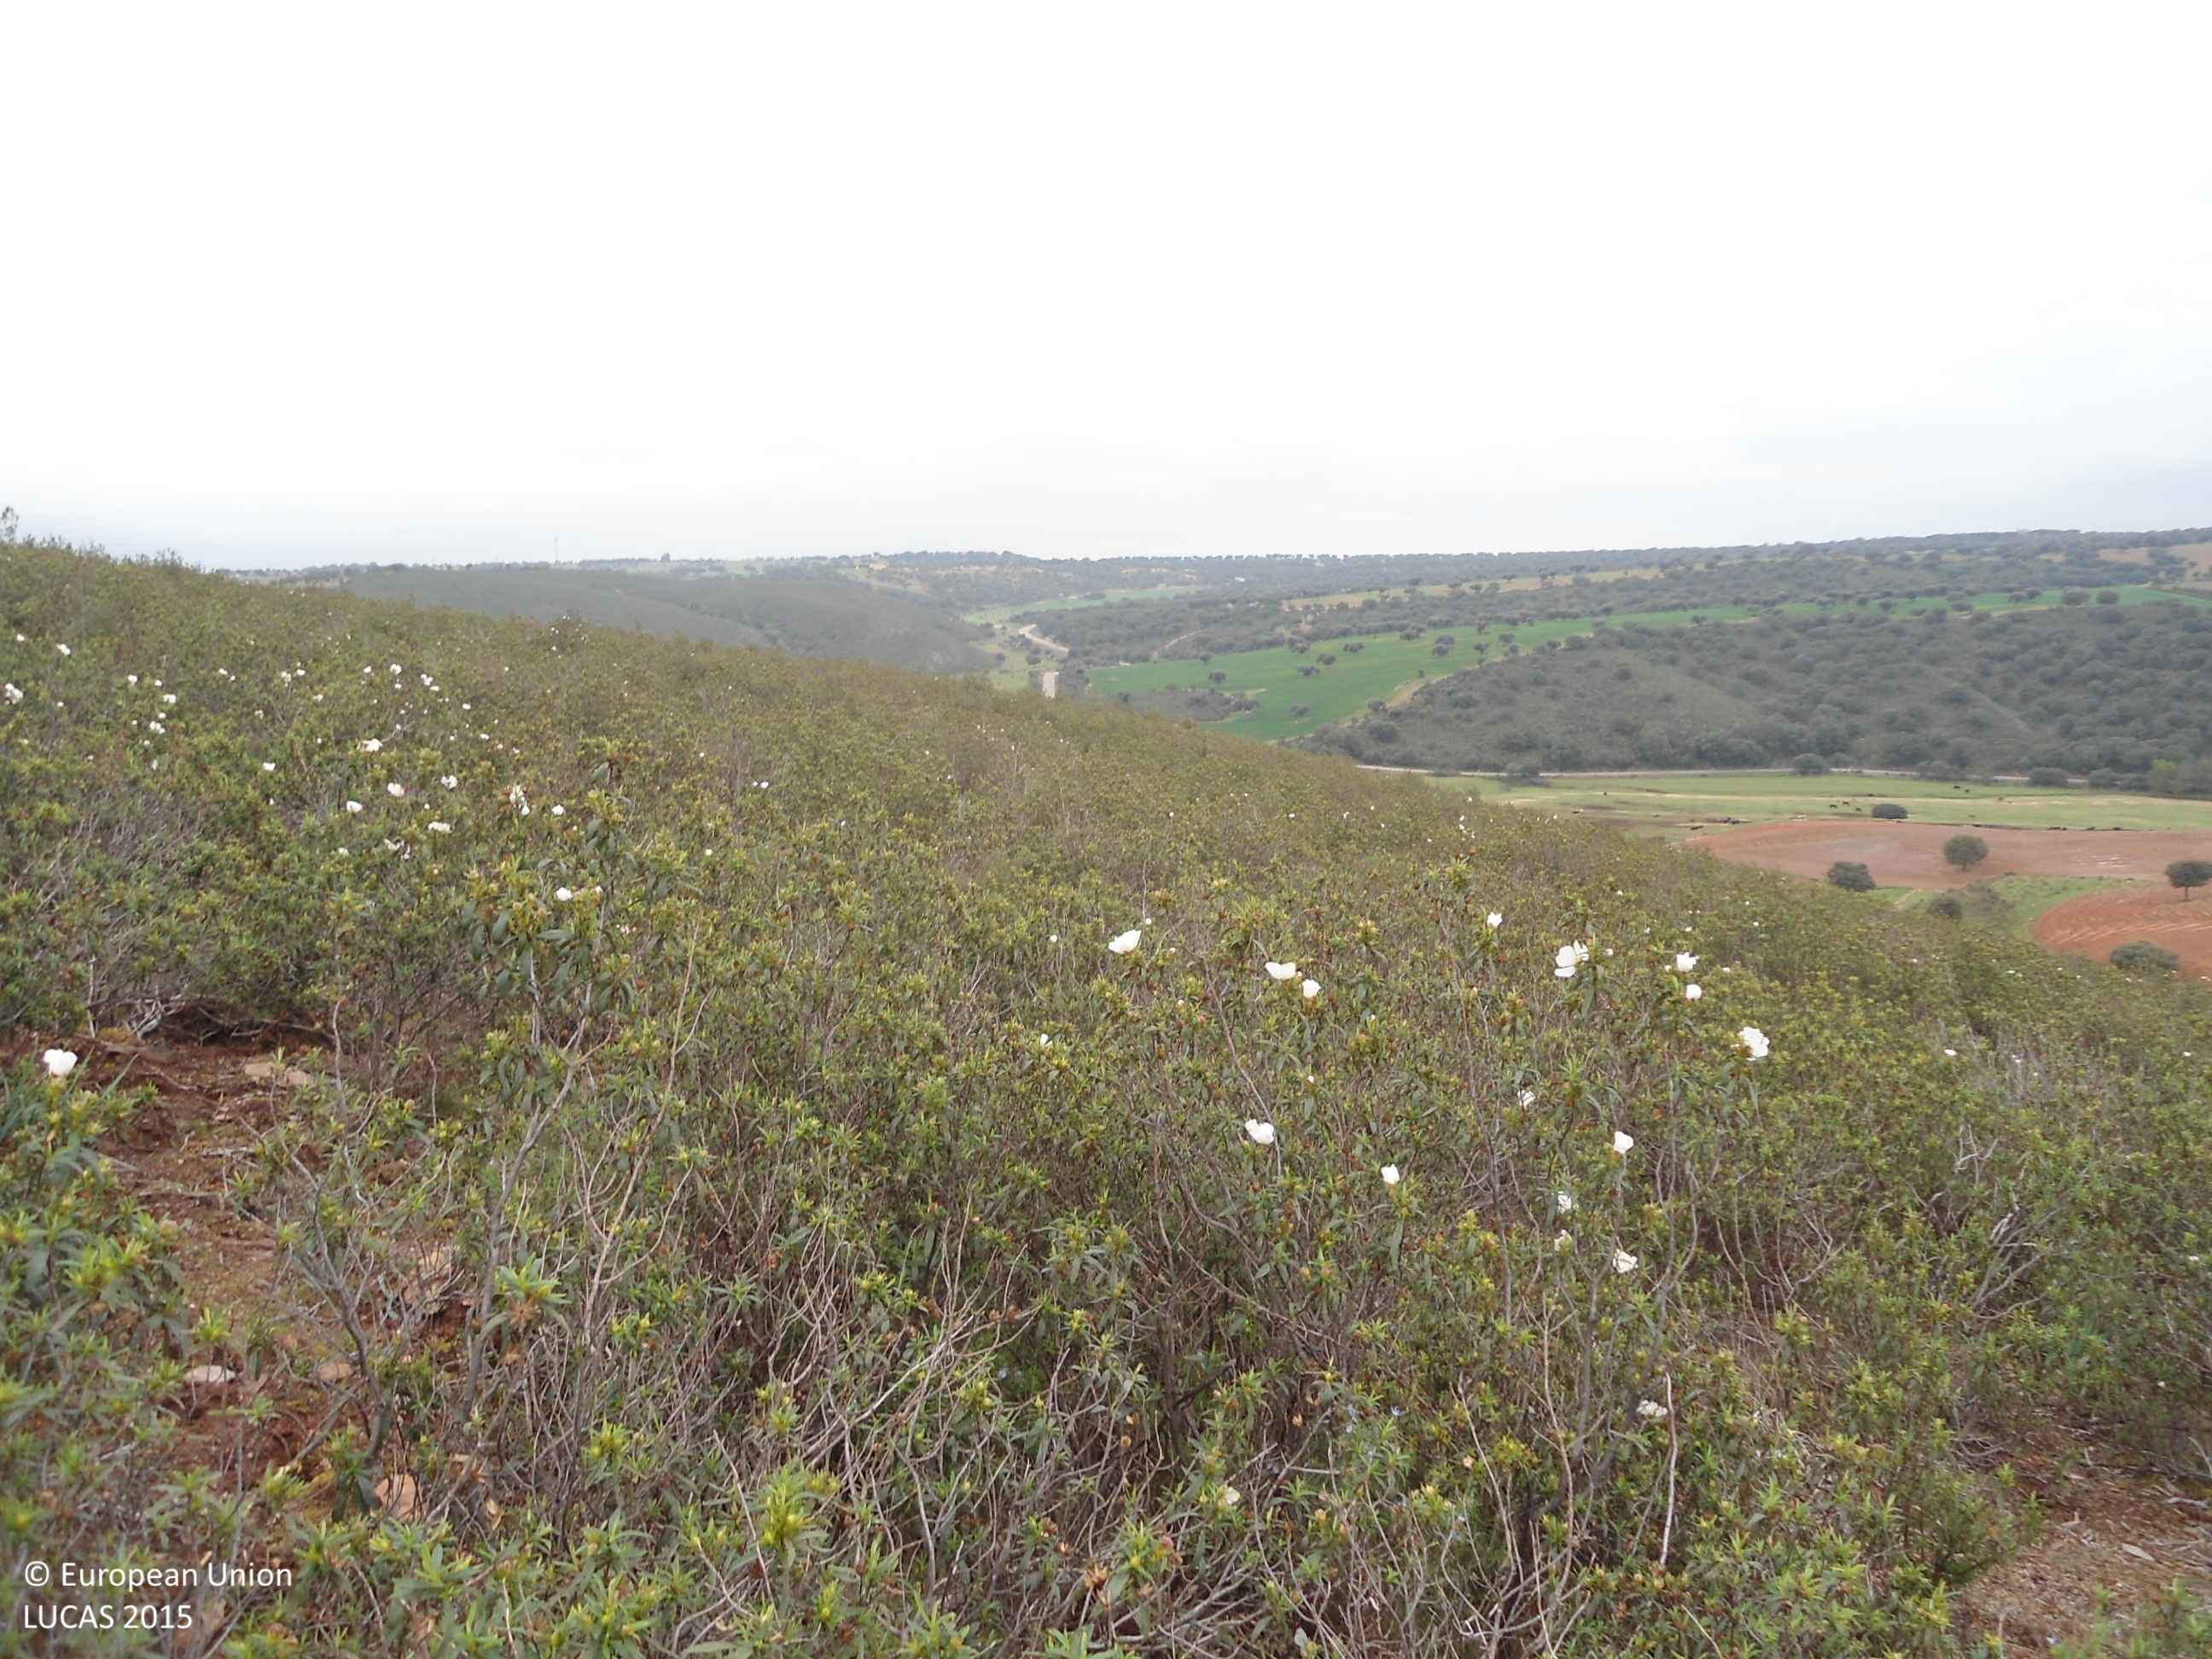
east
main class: Shrubland
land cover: Shrubland without tree cover
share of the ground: > 75 %
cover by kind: shrubs 100 %
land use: Abandoned areas
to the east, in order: Shrubland without tree cover; Rivers and streams; Shrubland without tree cover
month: April
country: ES
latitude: 41.5256
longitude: -5.8481
